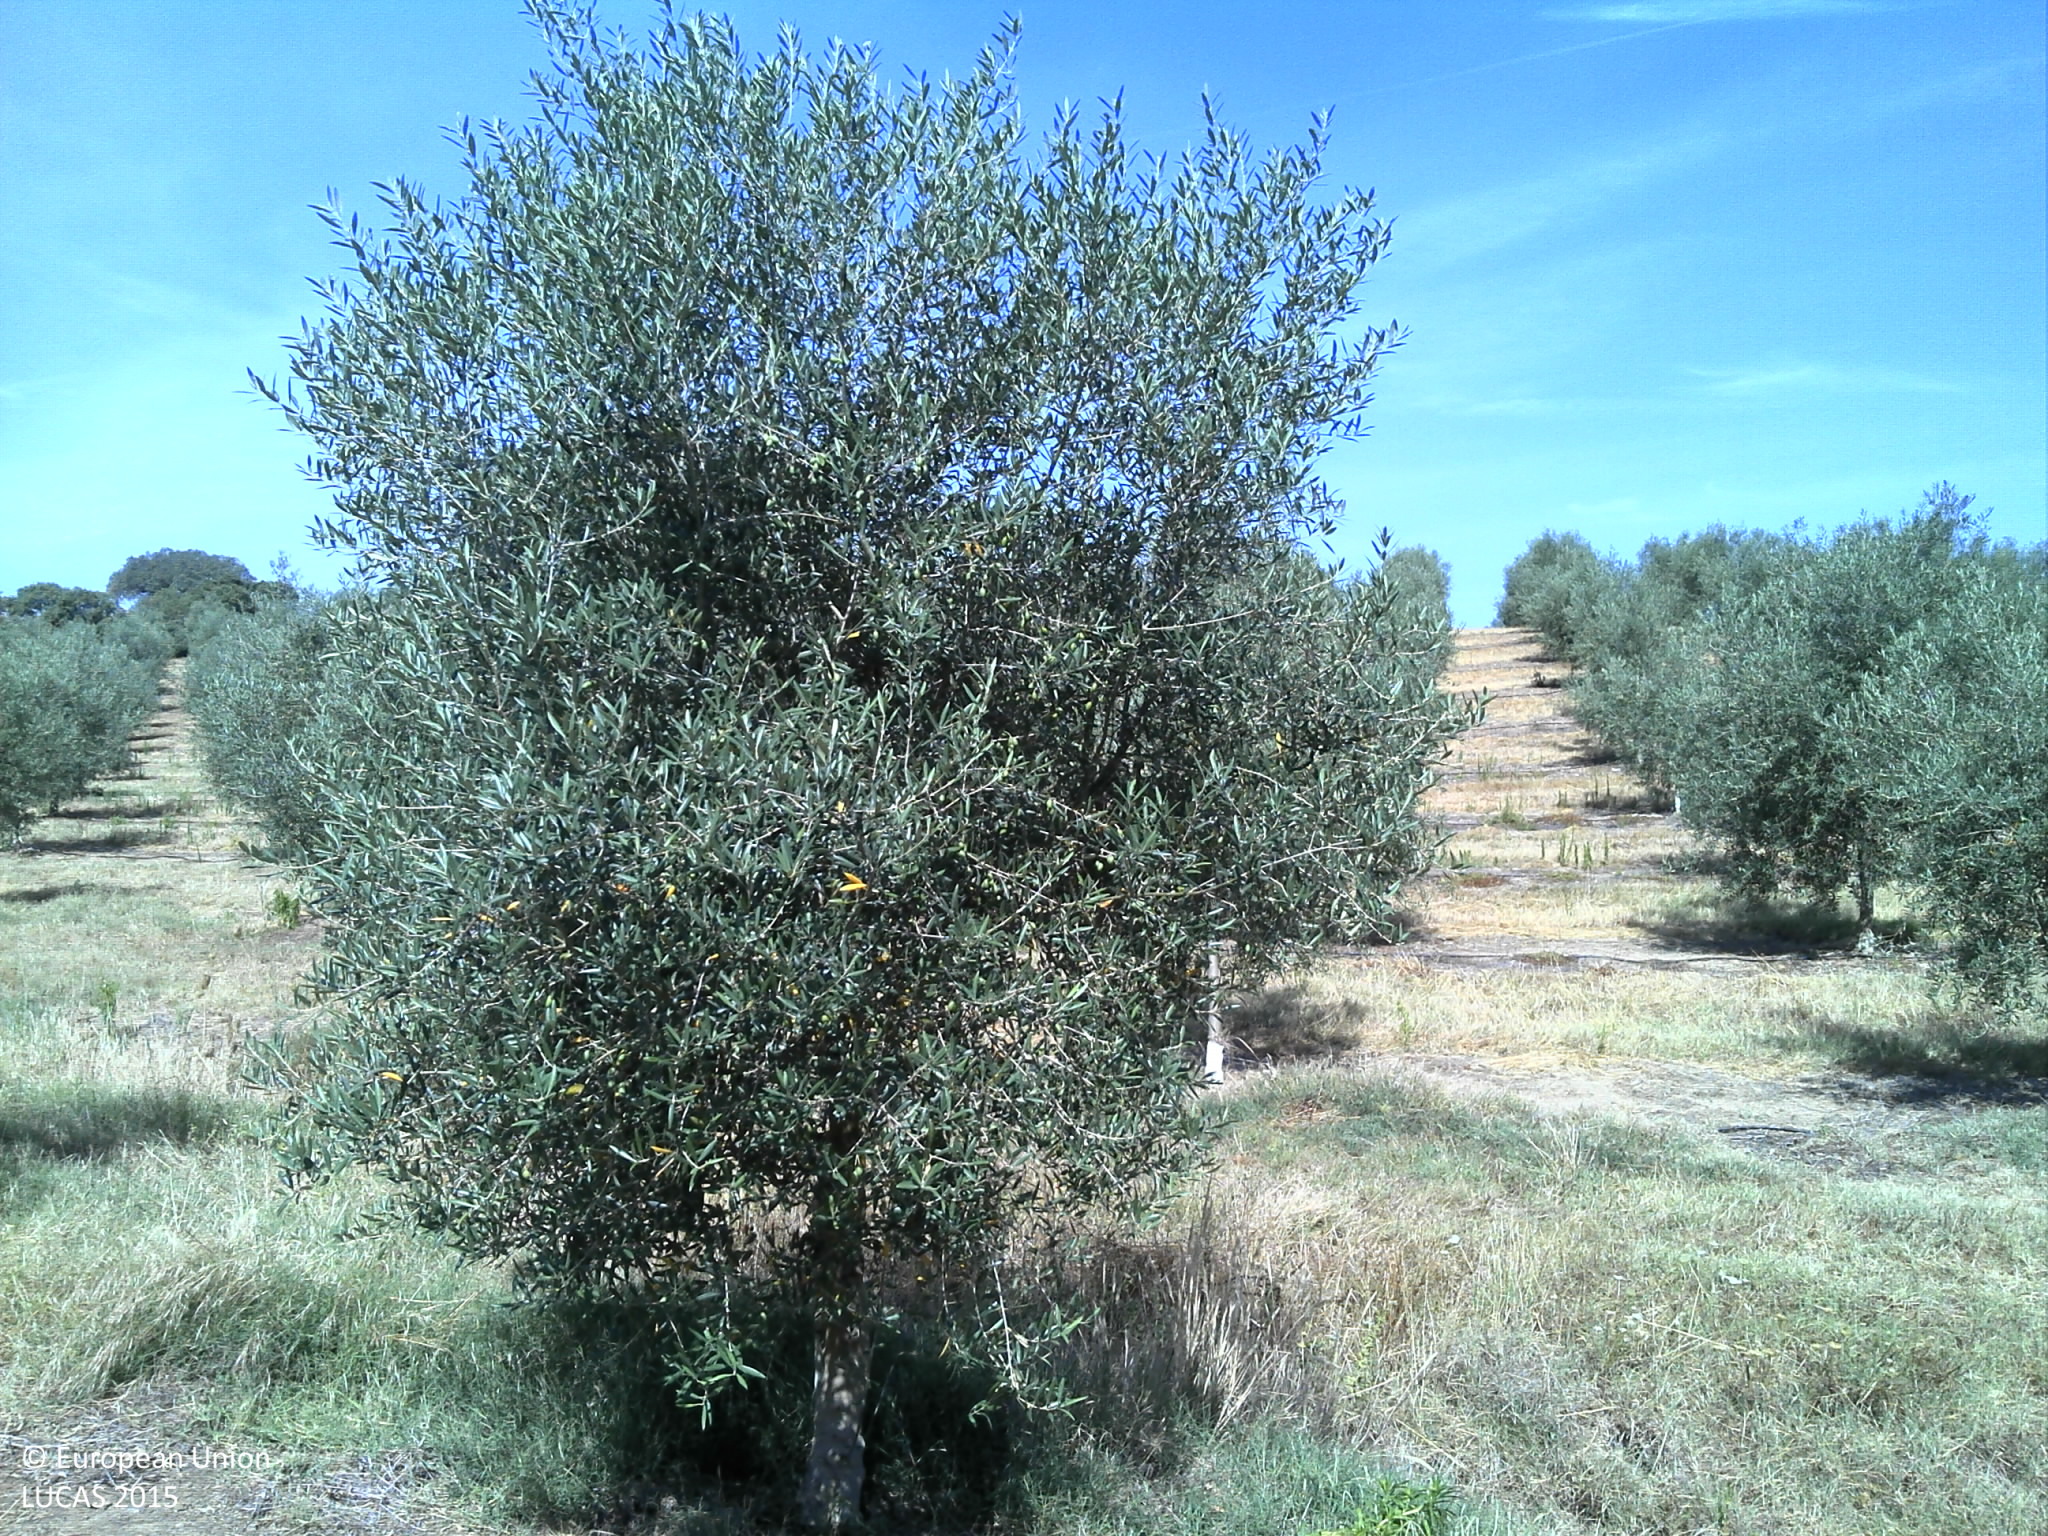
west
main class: Cropland
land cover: Olive groves
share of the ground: 10 - 25 %
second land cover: Grassland without tree/shrub cover
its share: 25 - 50 %
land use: Agriculture (excluding fallow land and kitchen gardens)
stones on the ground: < 10 %
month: July
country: PT
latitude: 38.4426
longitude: -7.6875
